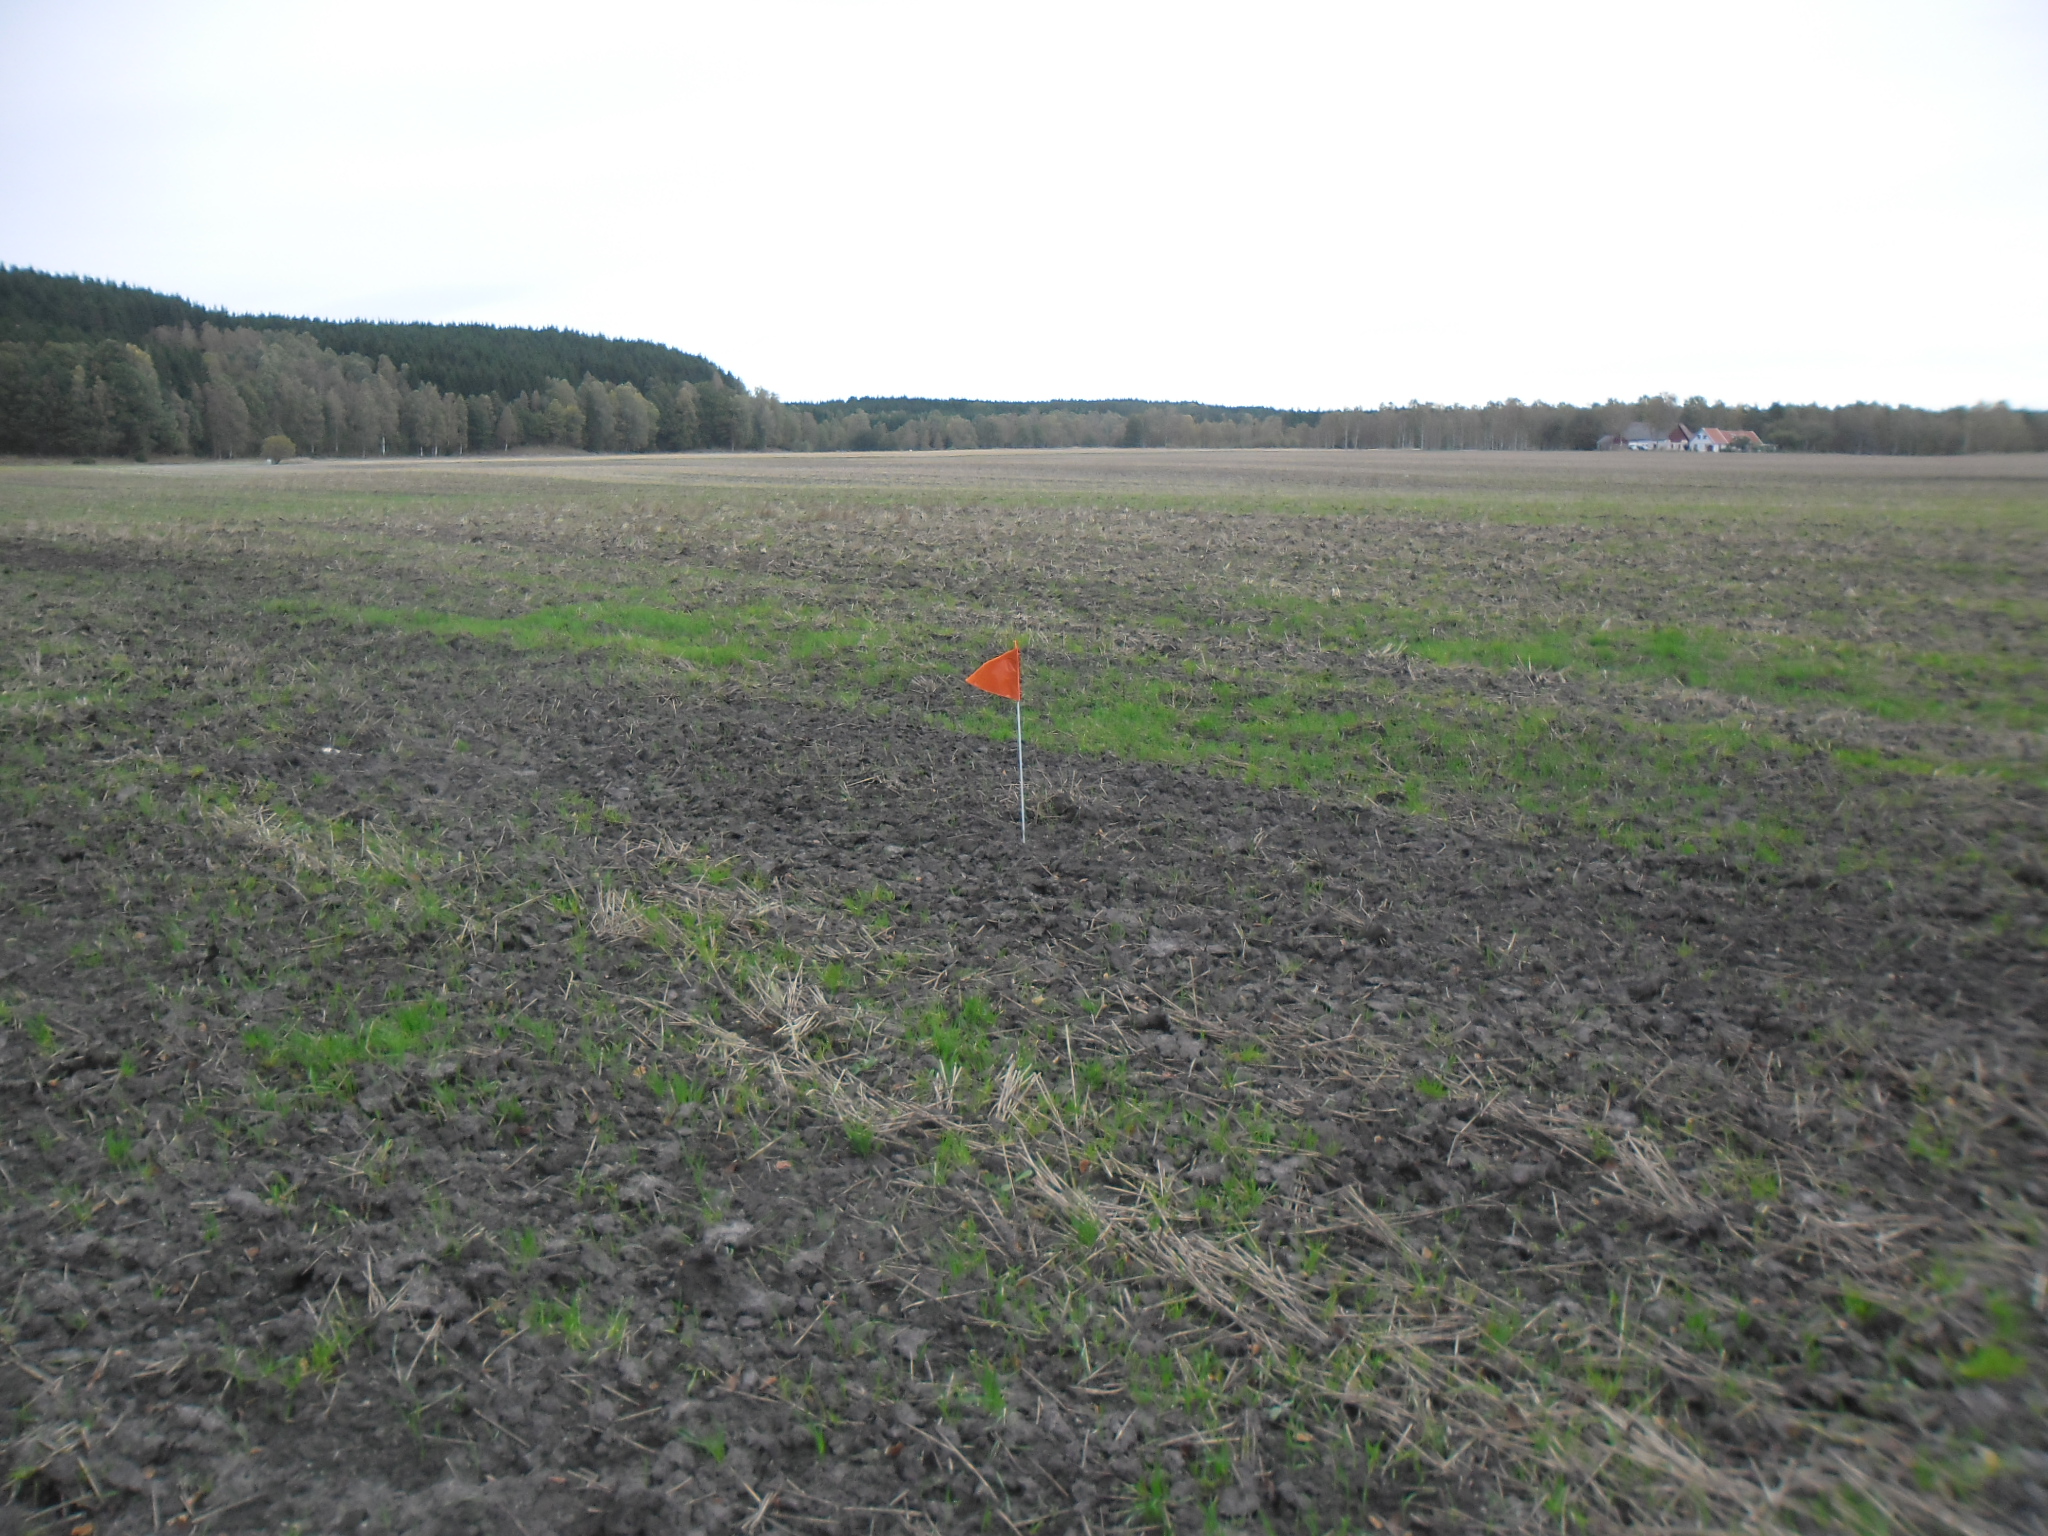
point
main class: Cropland
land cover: Common wheat
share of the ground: < 10 %
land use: Agriculture (excluding fallow land and kitchen gardens)
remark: Harvested field
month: October
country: SE
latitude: 56.5445
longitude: 13.1685
